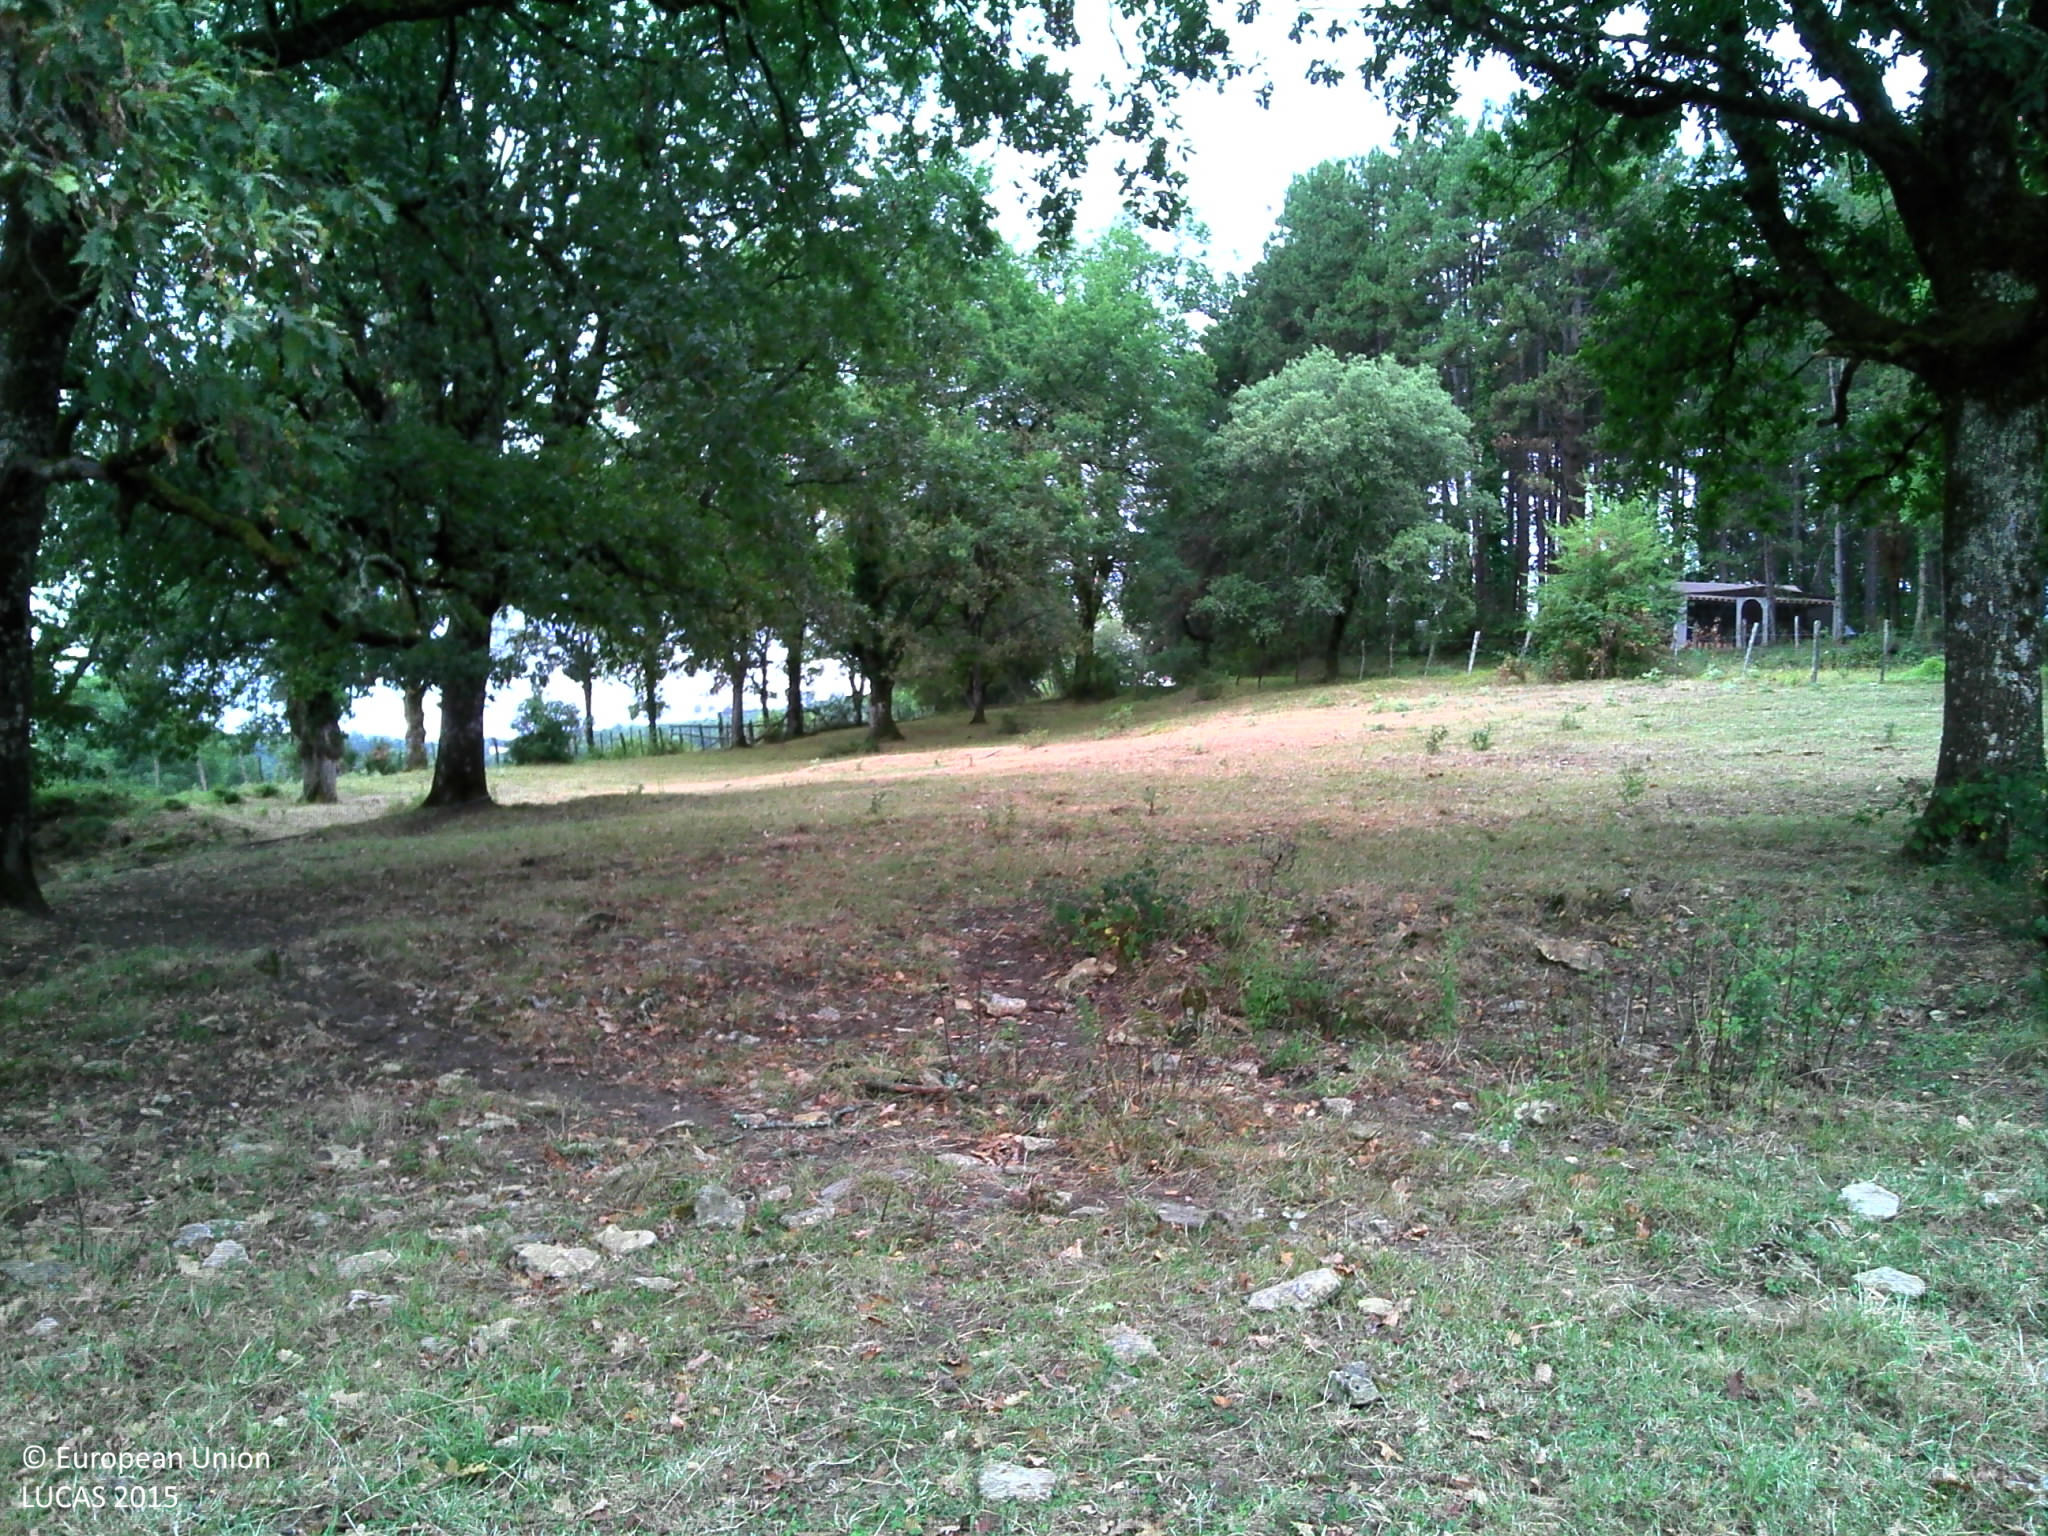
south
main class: Grassland
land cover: Grassland without tree/shrub cover
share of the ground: > 75 %
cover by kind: herbaceous plants 95 %, lichens and mosses 5 %
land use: Agriculture (excluding fallow land and kitchen gardens)
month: July
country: FR
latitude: 44.9560
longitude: 1.2098
